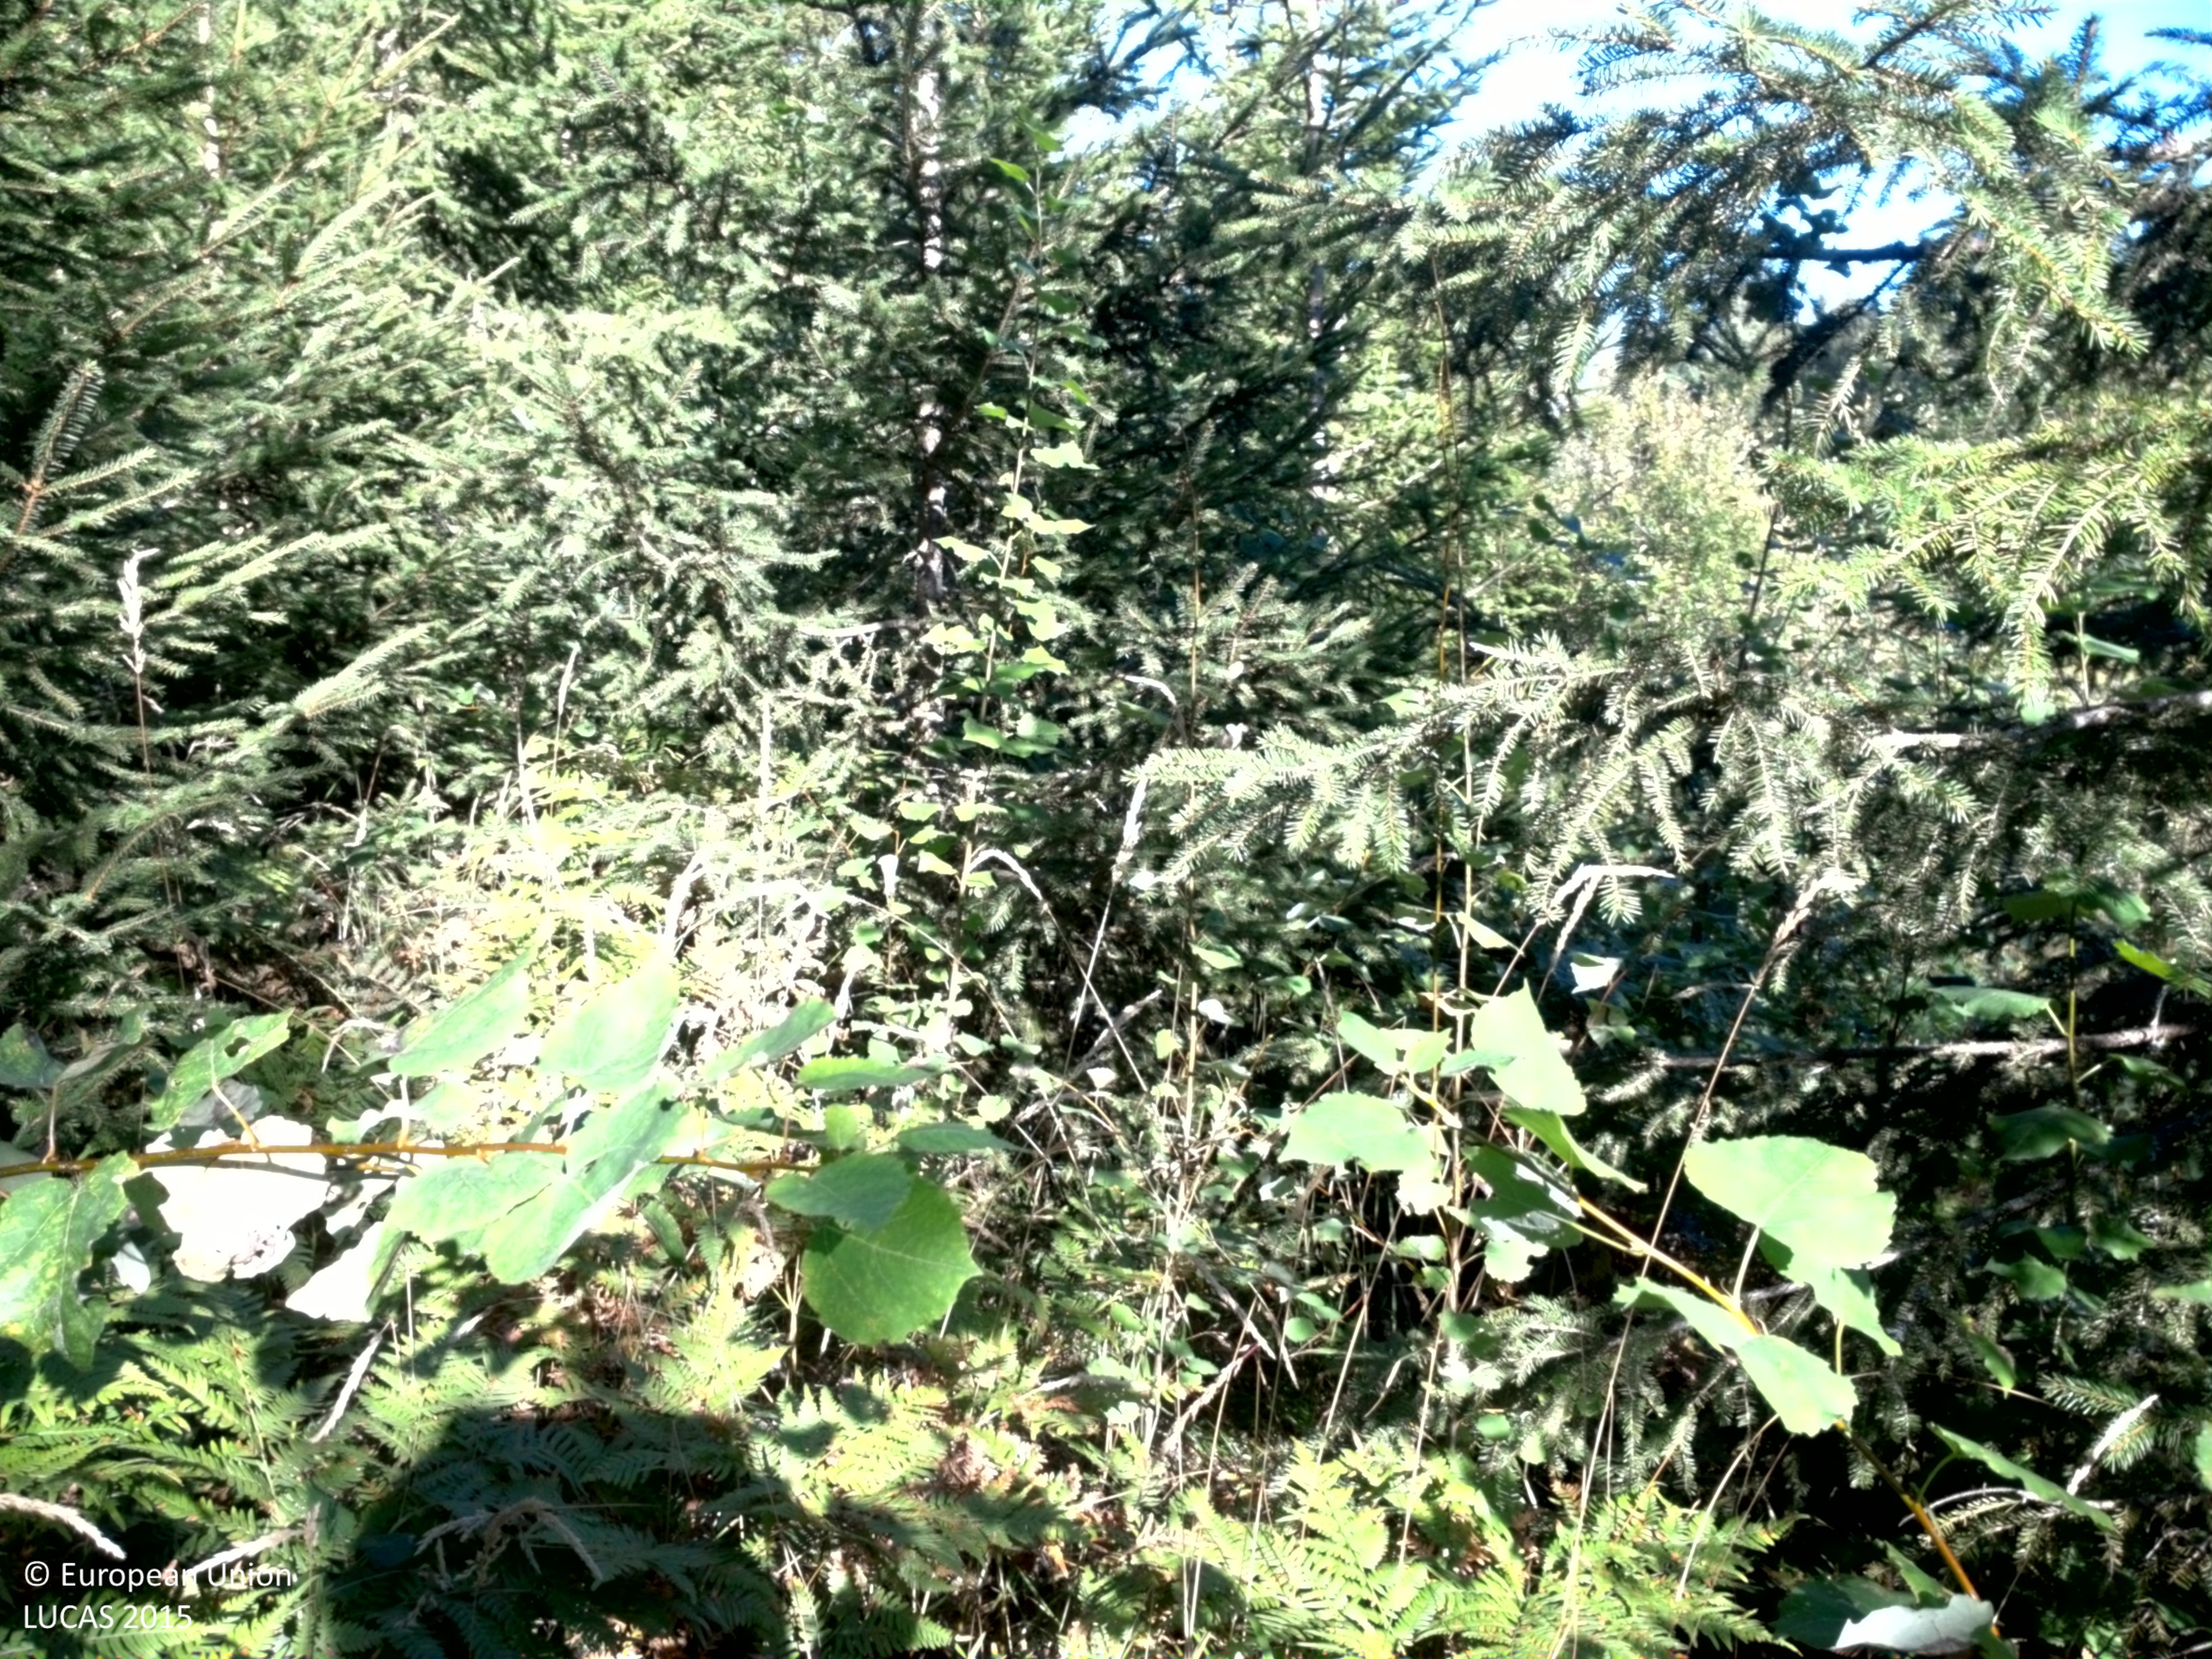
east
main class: Woodland
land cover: Spruce dominated mixed woodland
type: boreal forest
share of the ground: > 75 %
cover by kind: broadleaved forest trees 50 %, coniferous forest trees 40 %, herbaceous plants 10 %
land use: Forestry
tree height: > 5 m
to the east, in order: Spruce dominated mixed woodland; Paved roads, cycling and walking lanes; Fences; Grassland with sparse tree/shrub cover
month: August
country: SE
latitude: 59.5868
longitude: 15.9240
